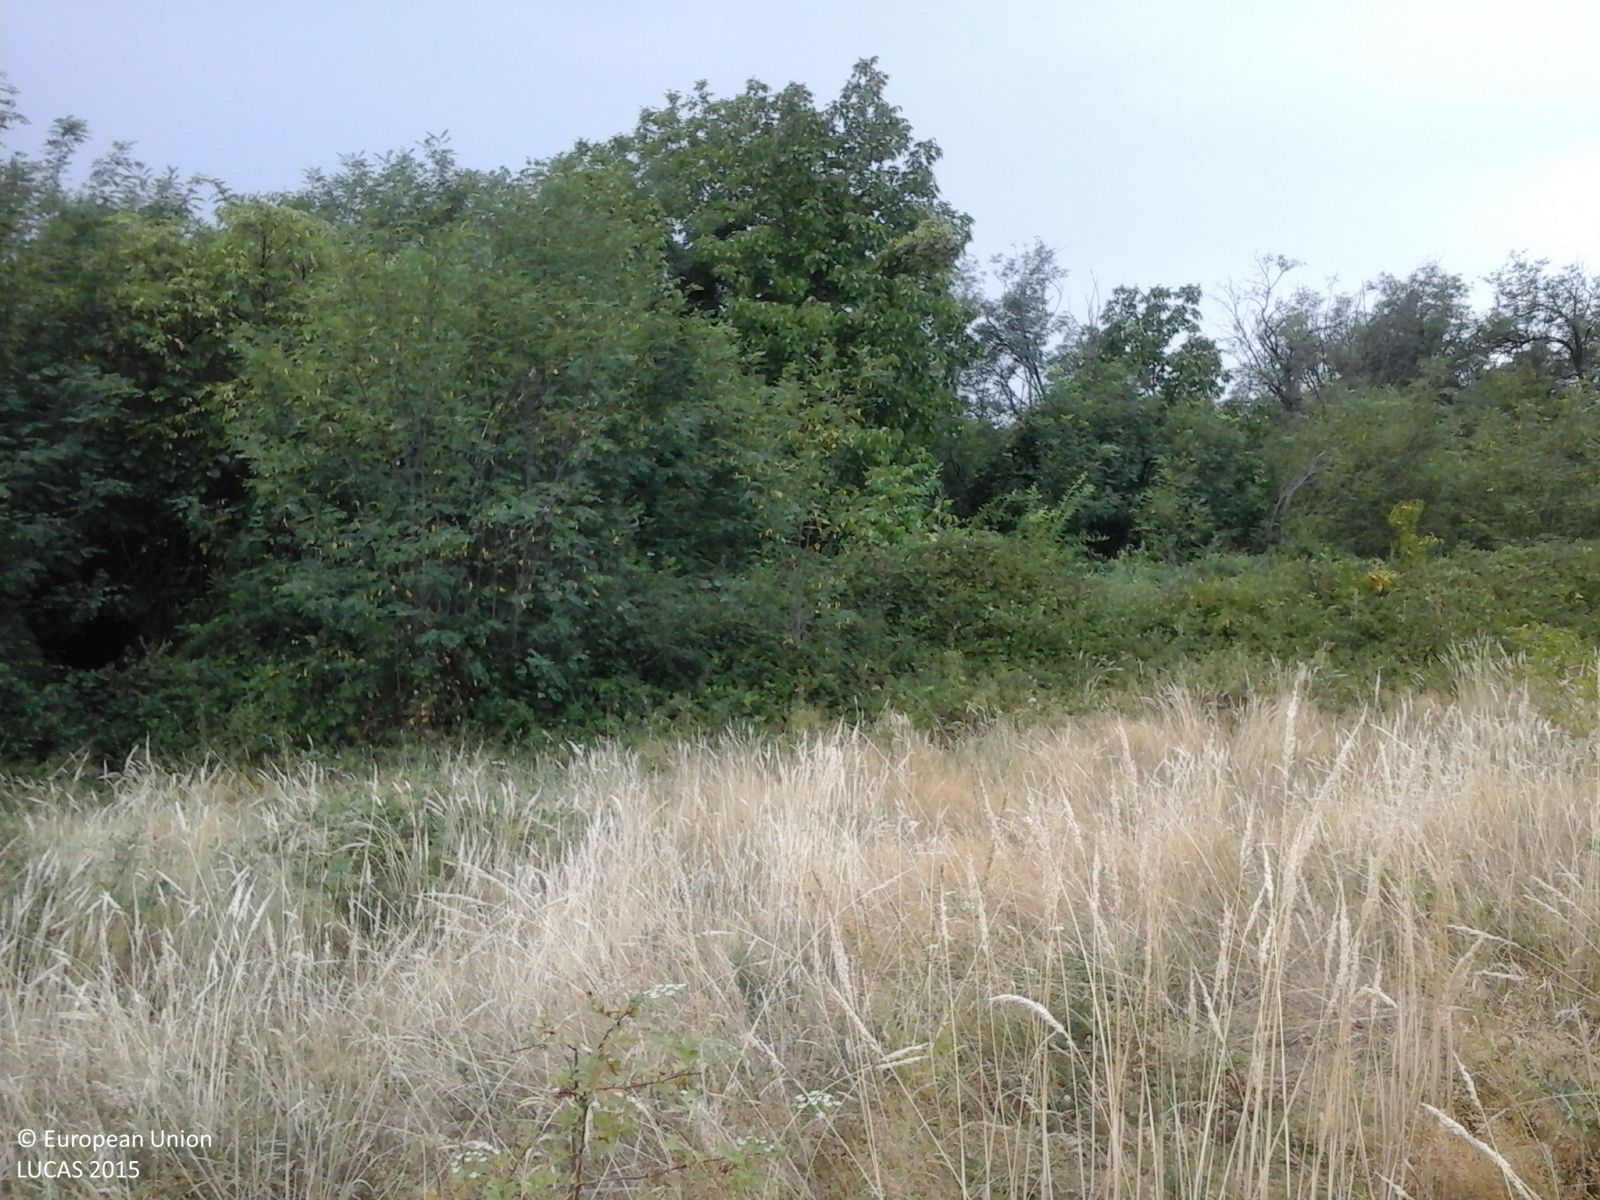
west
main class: Grassland
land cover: Grassland with sparse tree/shrub cover
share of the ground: > 75 %
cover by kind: herbaceous plants 85 %, shrubs 10 %, broadleaved forest trees 5 %
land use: Fallow land
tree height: < 5 m
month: August
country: RO
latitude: 44.7591
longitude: 22.7911
